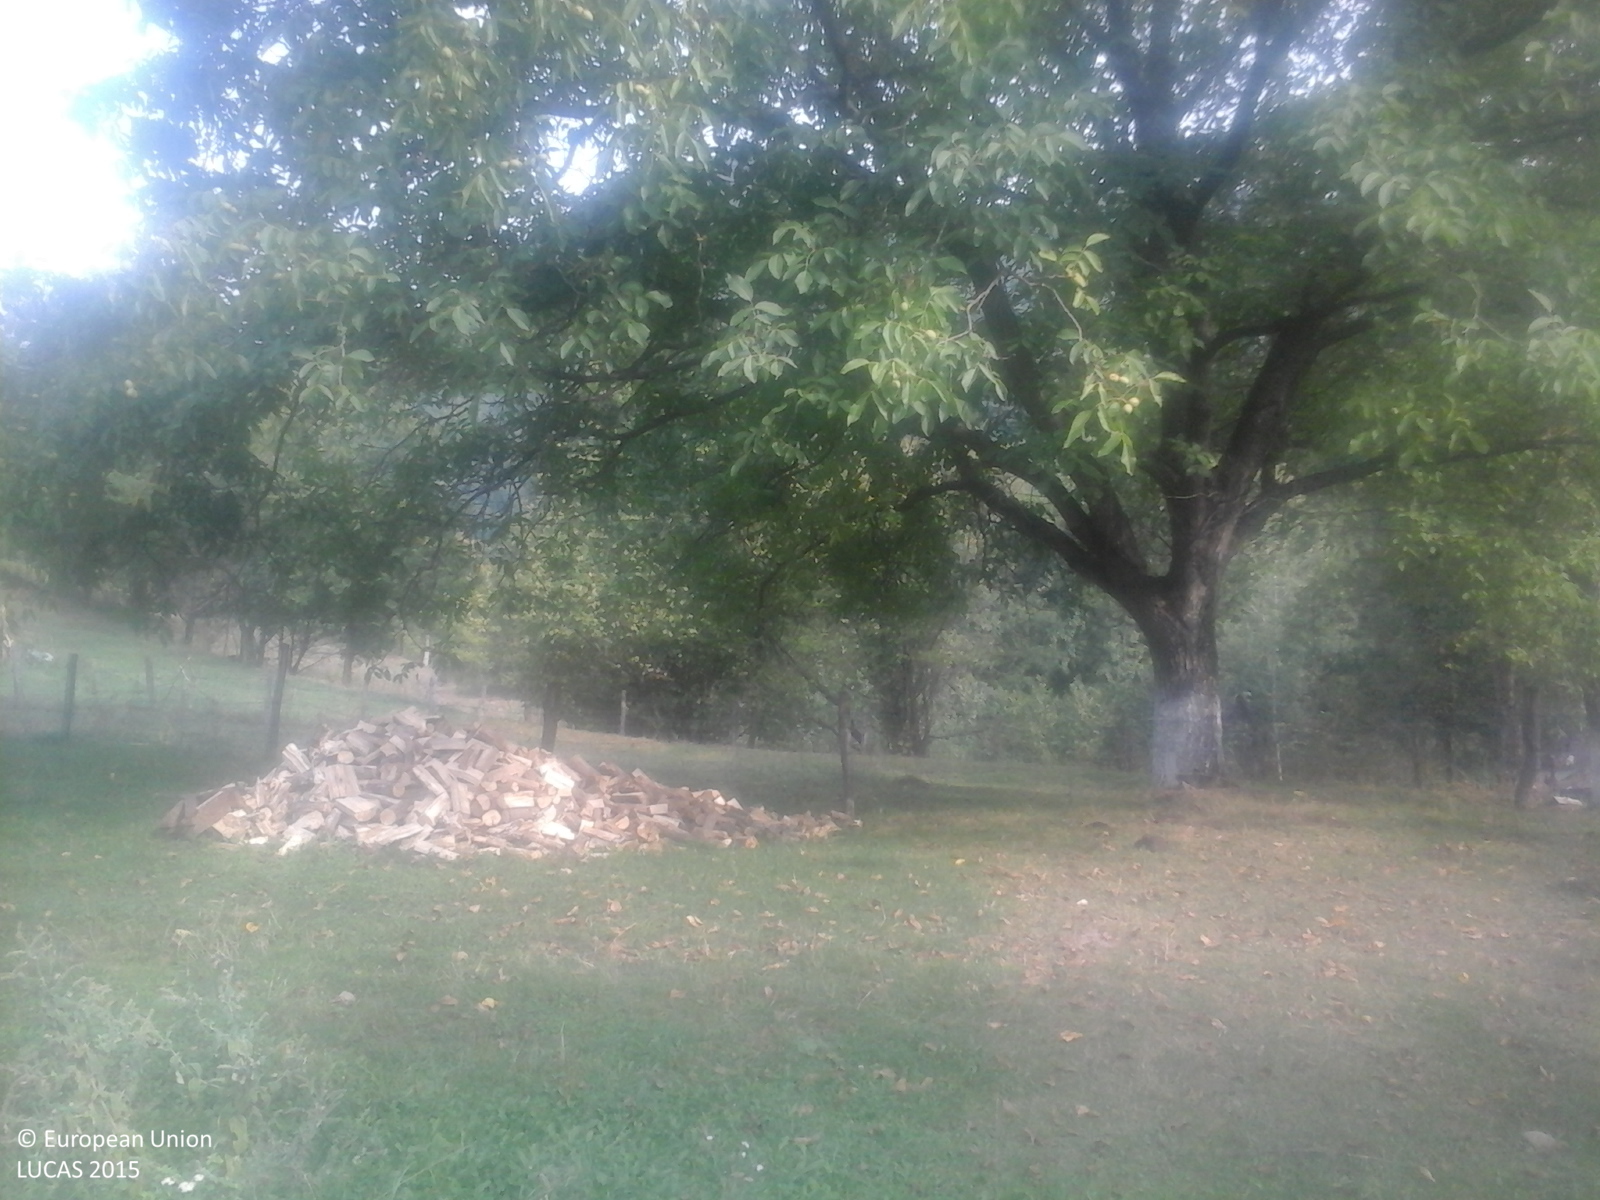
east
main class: Cropland
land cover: Apple fruit
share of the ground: > 75 %
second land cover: Grassland without tree/shrub cover
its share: > 75 %
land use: Agriculture (excluding fallow land and kitchen gardens)
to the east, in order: Apple fruit; Grassland without tree/shrub cover; Fences; Grass margins; Tracks; Grassland without tree/shrub cover; Electric lines; Grassland without tree/shrub cover; Fences; Other fruit trees and berries; Fences; Other fruit trees and berries; Broadleaved woodland; Arable land (only in case pi); Broadleaved woodland
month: September
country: RO
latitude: 46.0919
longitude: 22.9247
